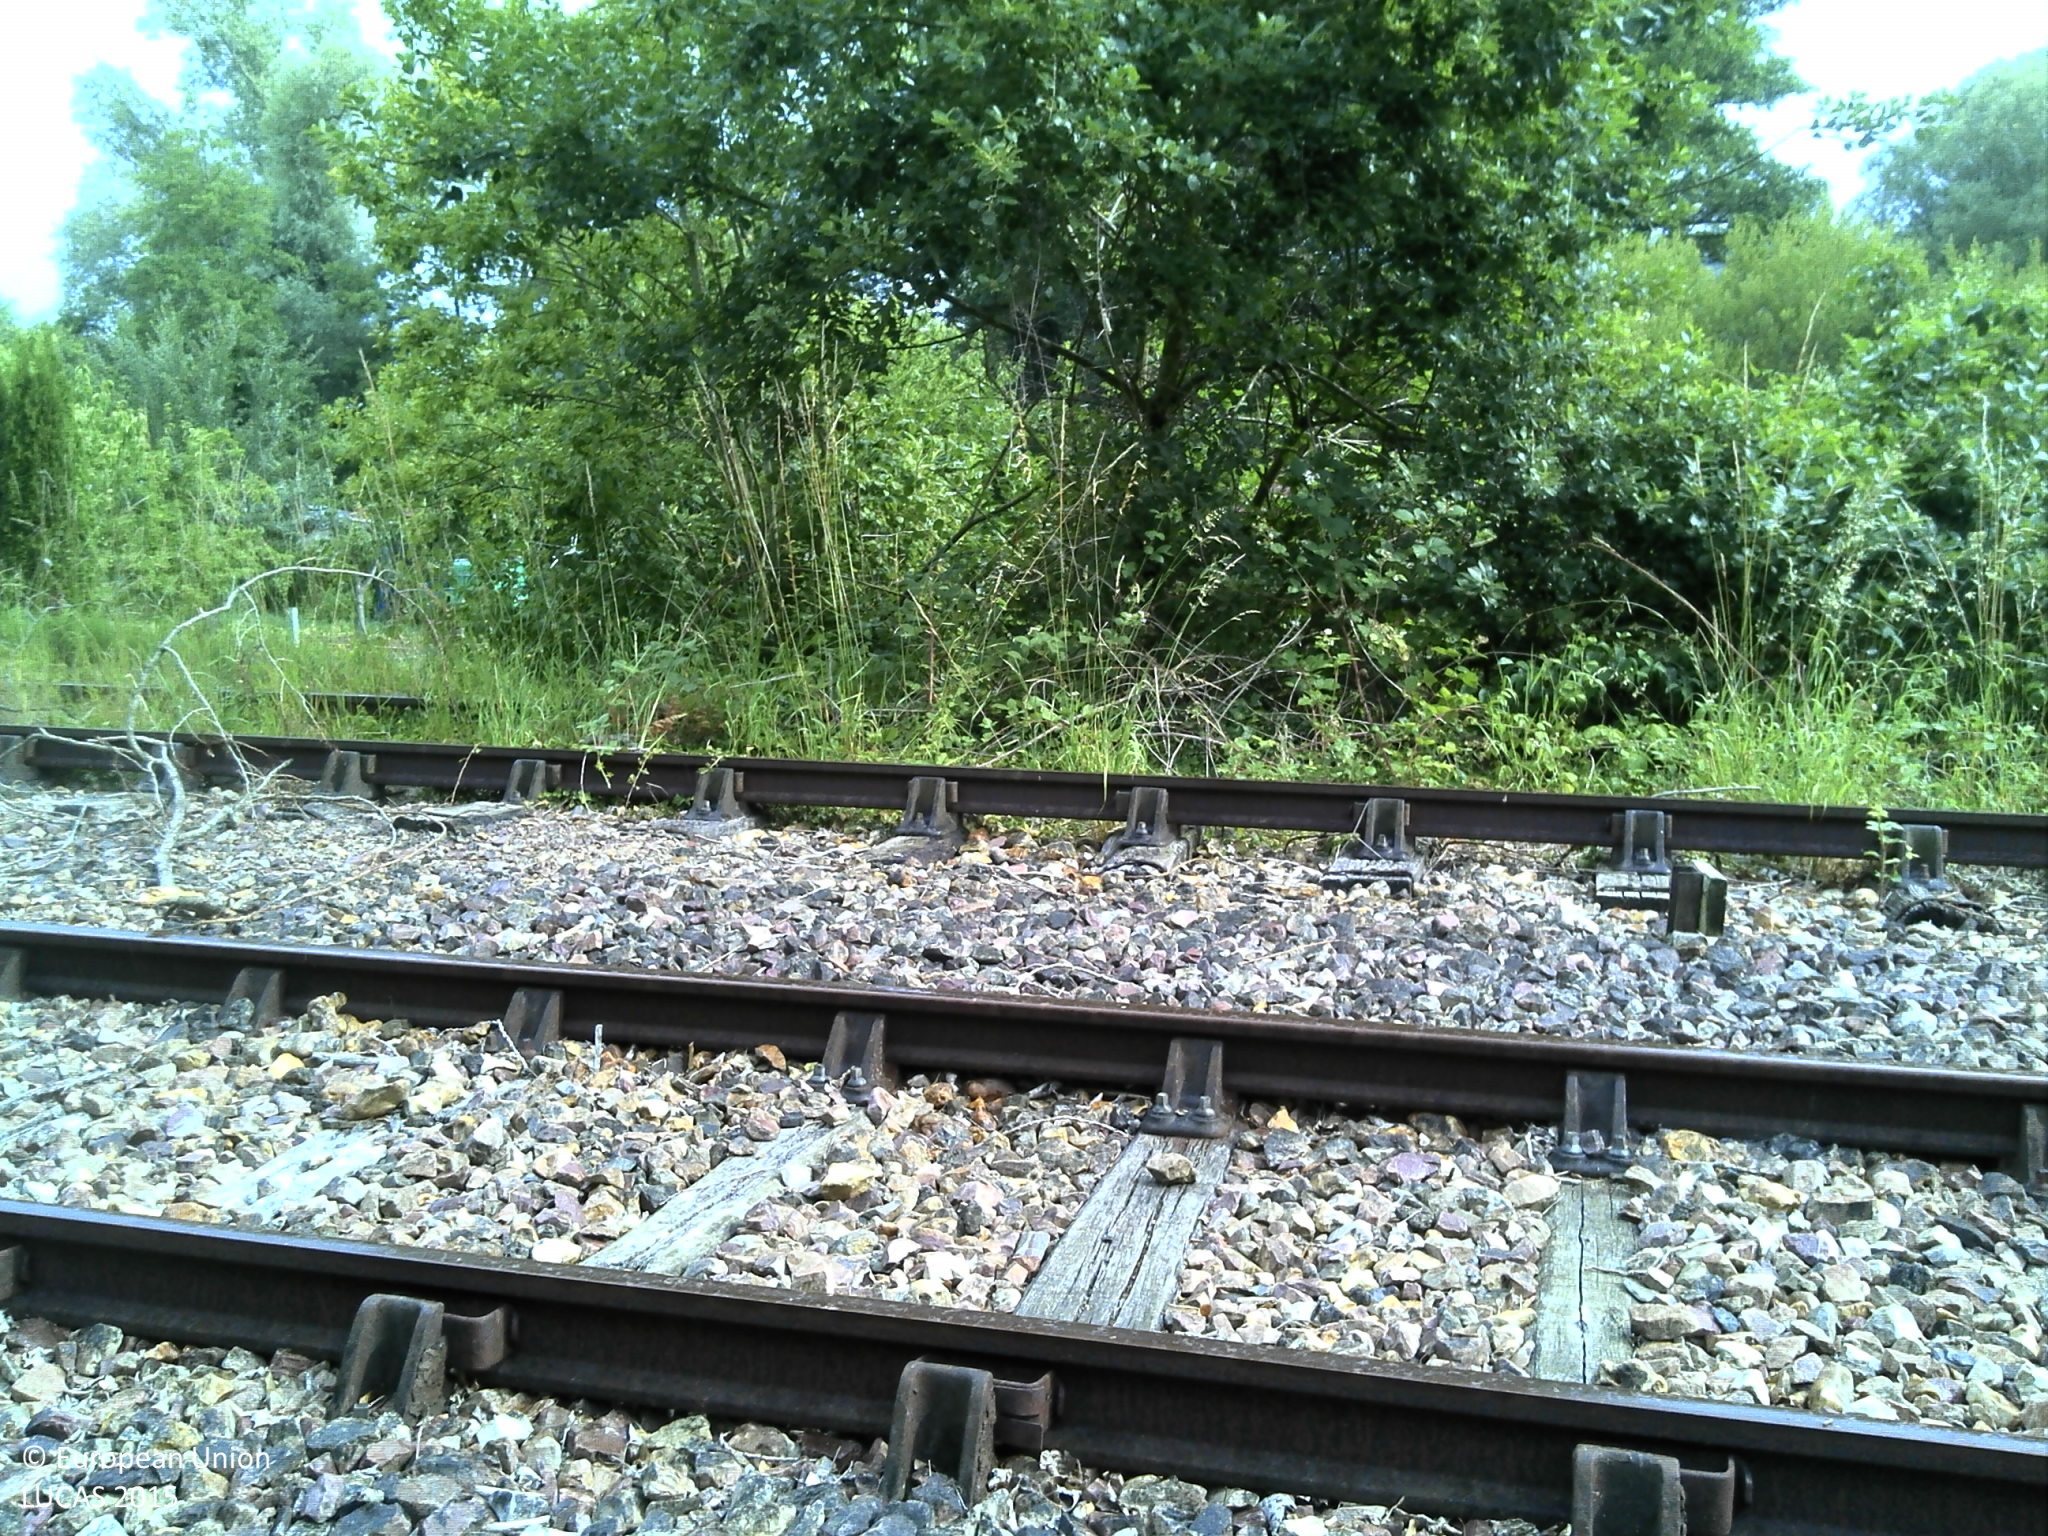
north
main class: Woodland
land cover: Broadleaved woodland
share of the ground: 50 - 75 %
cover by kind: broadleaved forest trees 100 %
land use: Semi-natural and natural areas not in use
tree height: < 5 m
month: July
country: FR
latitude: 49.8751
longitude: 1.1424
